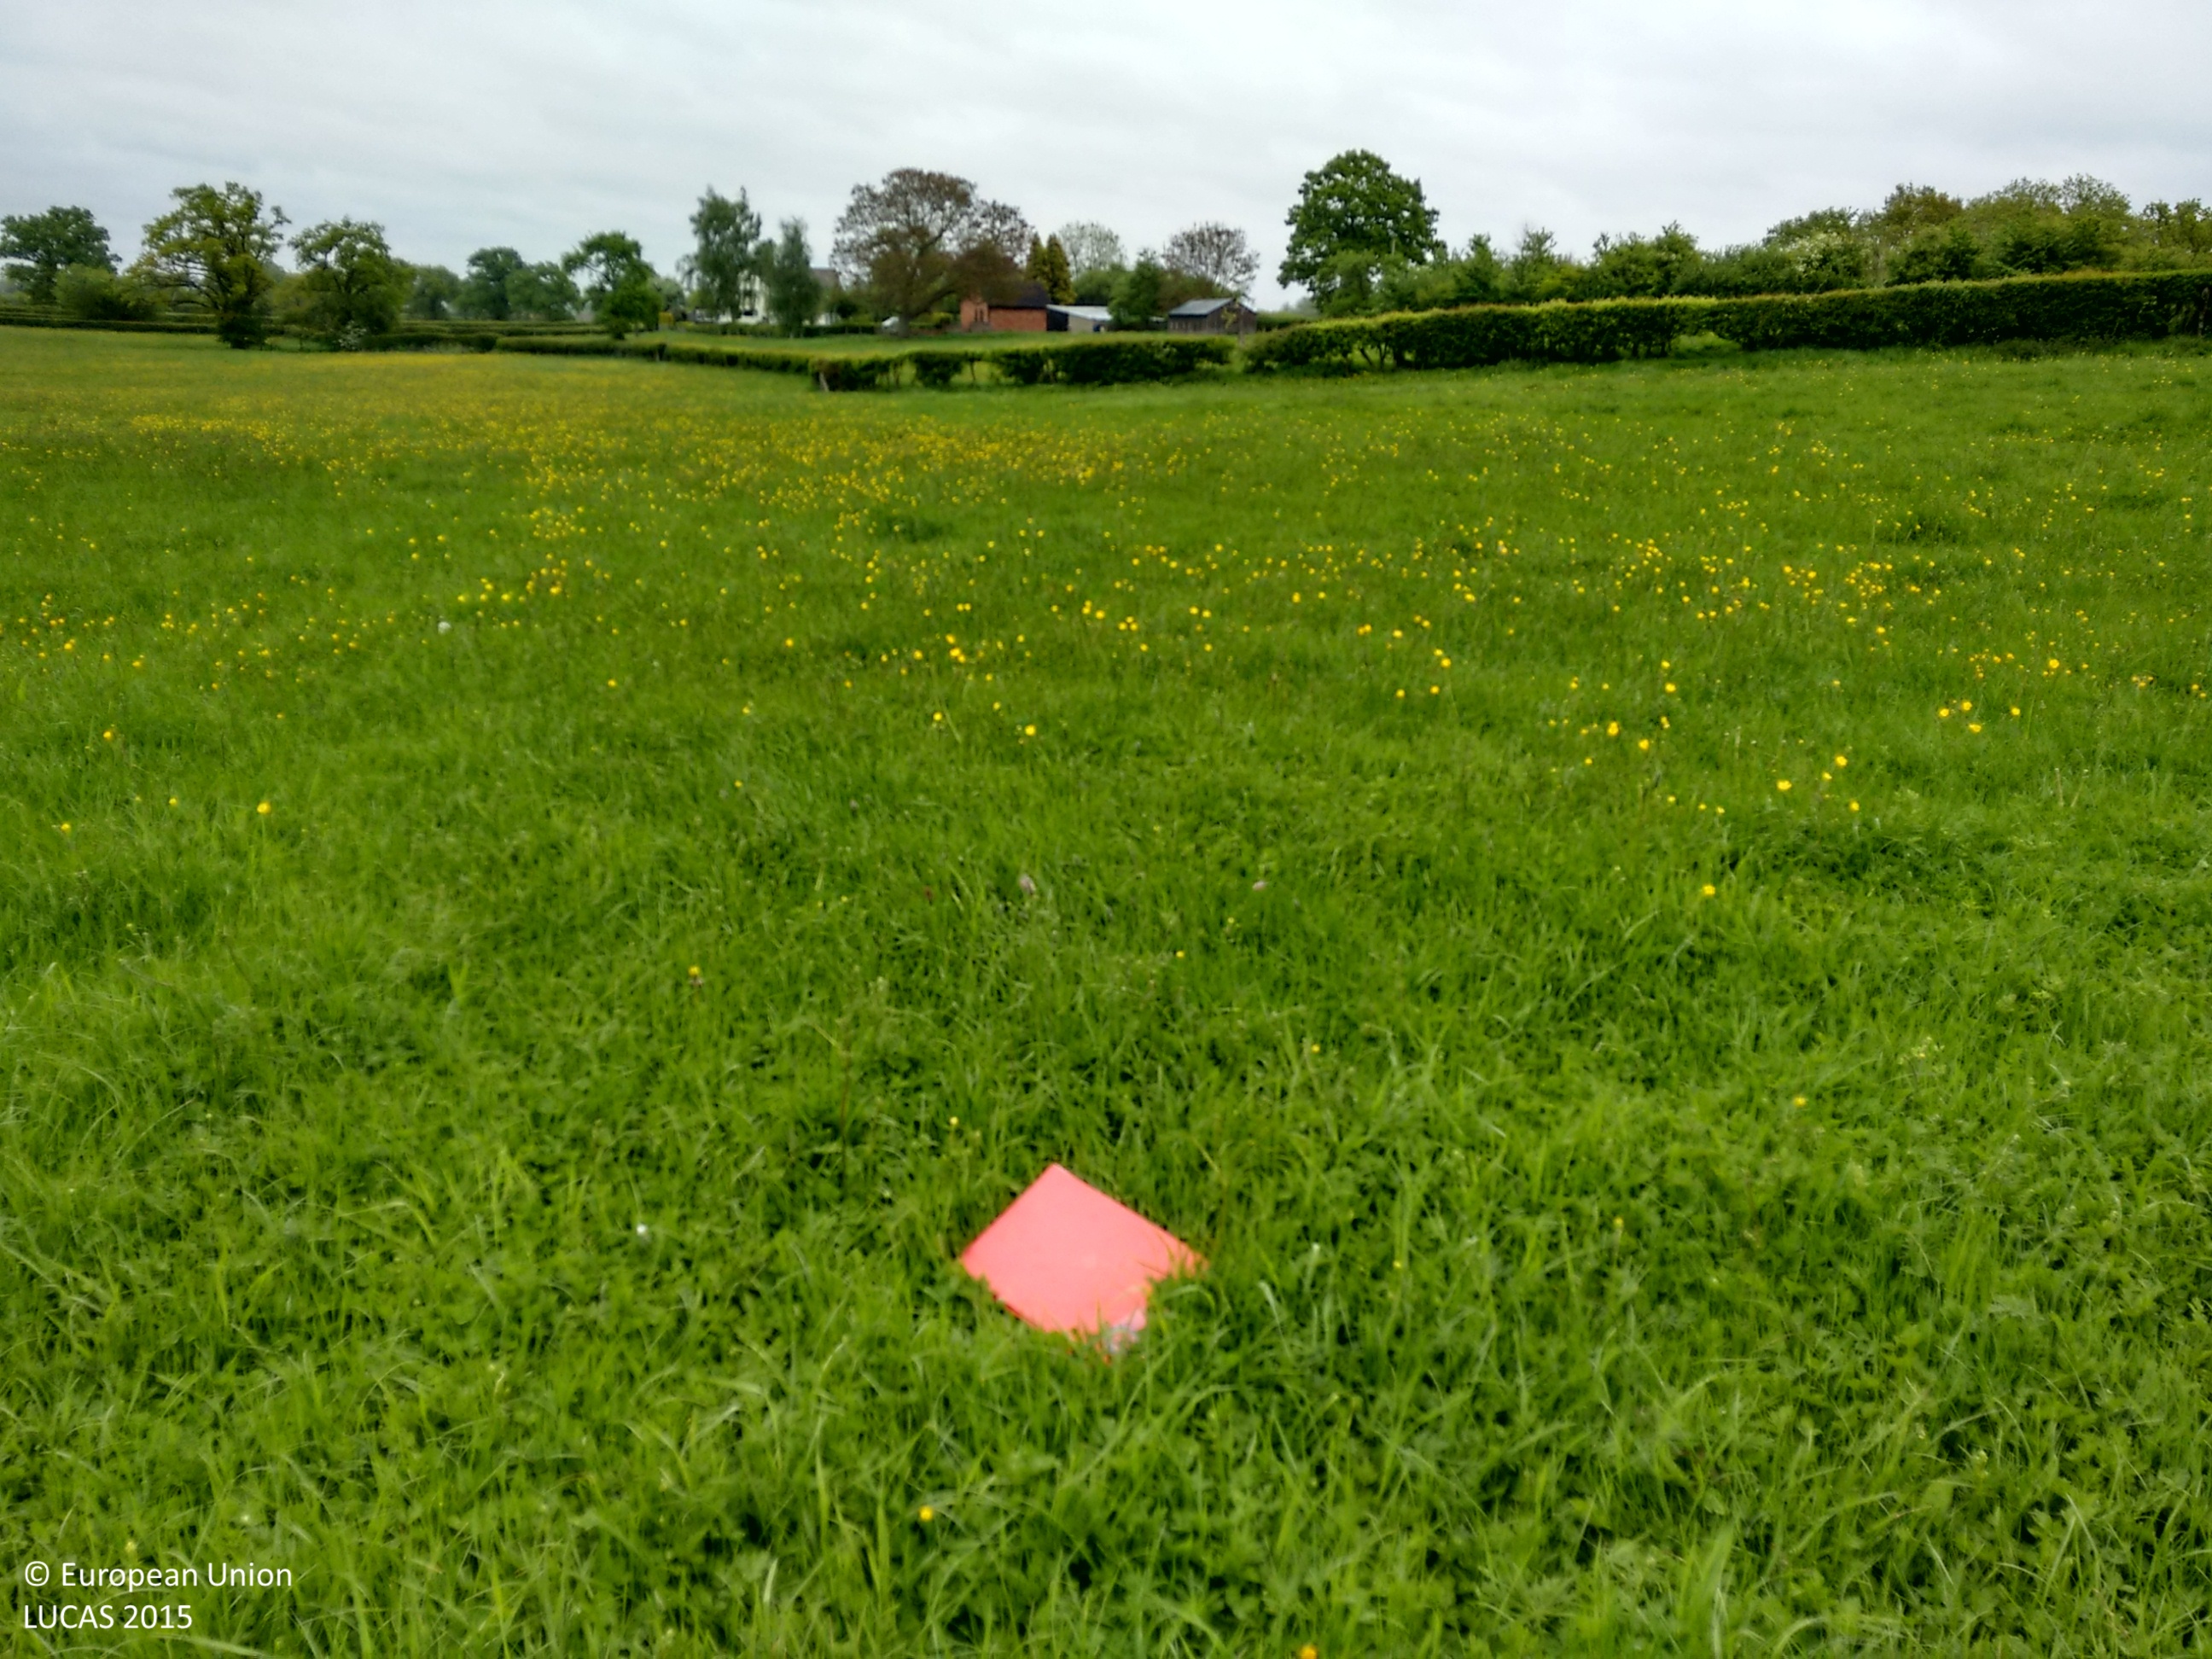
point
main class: Grassland
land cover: Grassland without tree/shrub cover
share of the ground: > 75 %
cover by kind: herbaceous plants 100 %
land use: Agriculture (excluding fallow land and kitchen gardens)
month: May
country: GB
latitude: 52.3308
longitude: -2.1674
